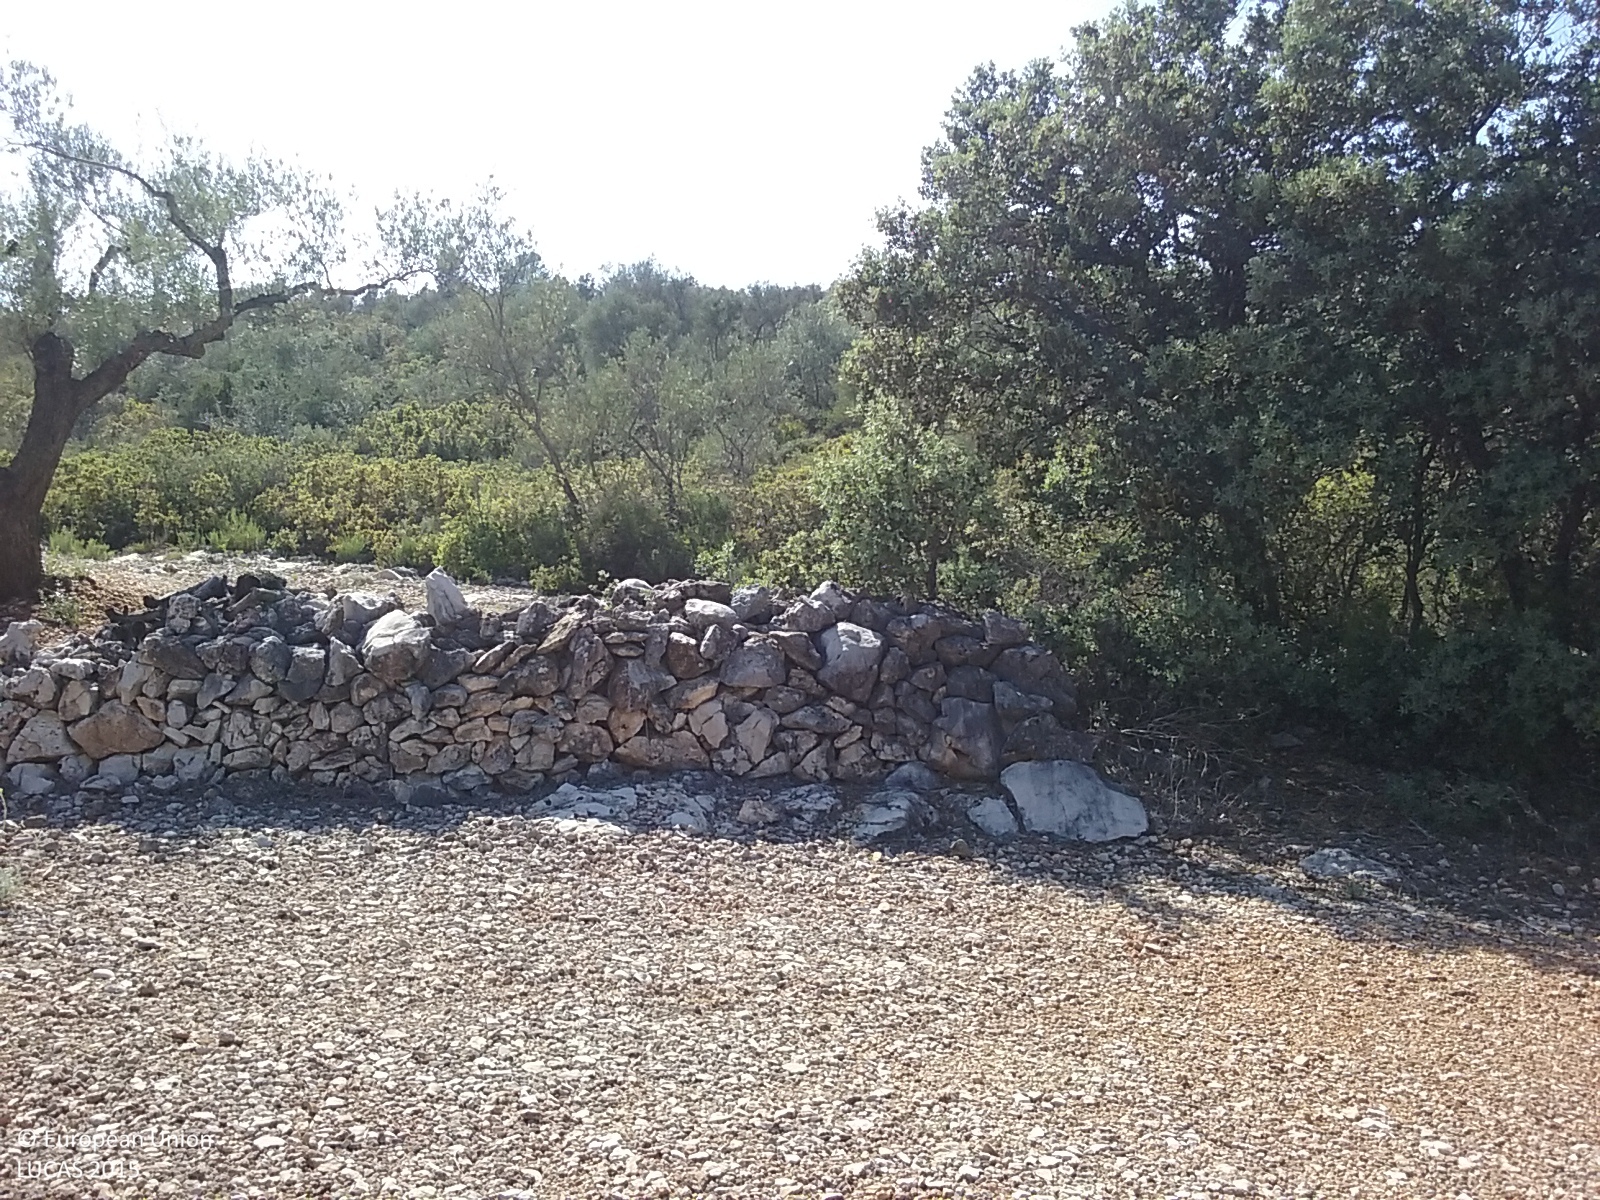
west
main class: Cropland
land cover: Olive groves
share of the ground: 25 - 50 %
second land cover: Other bare soil
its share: > 75 %
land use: Agriculture (excluding fallow land and kitchen gardens)
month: May
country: ES
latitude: 40.5995
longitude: 0.2453
